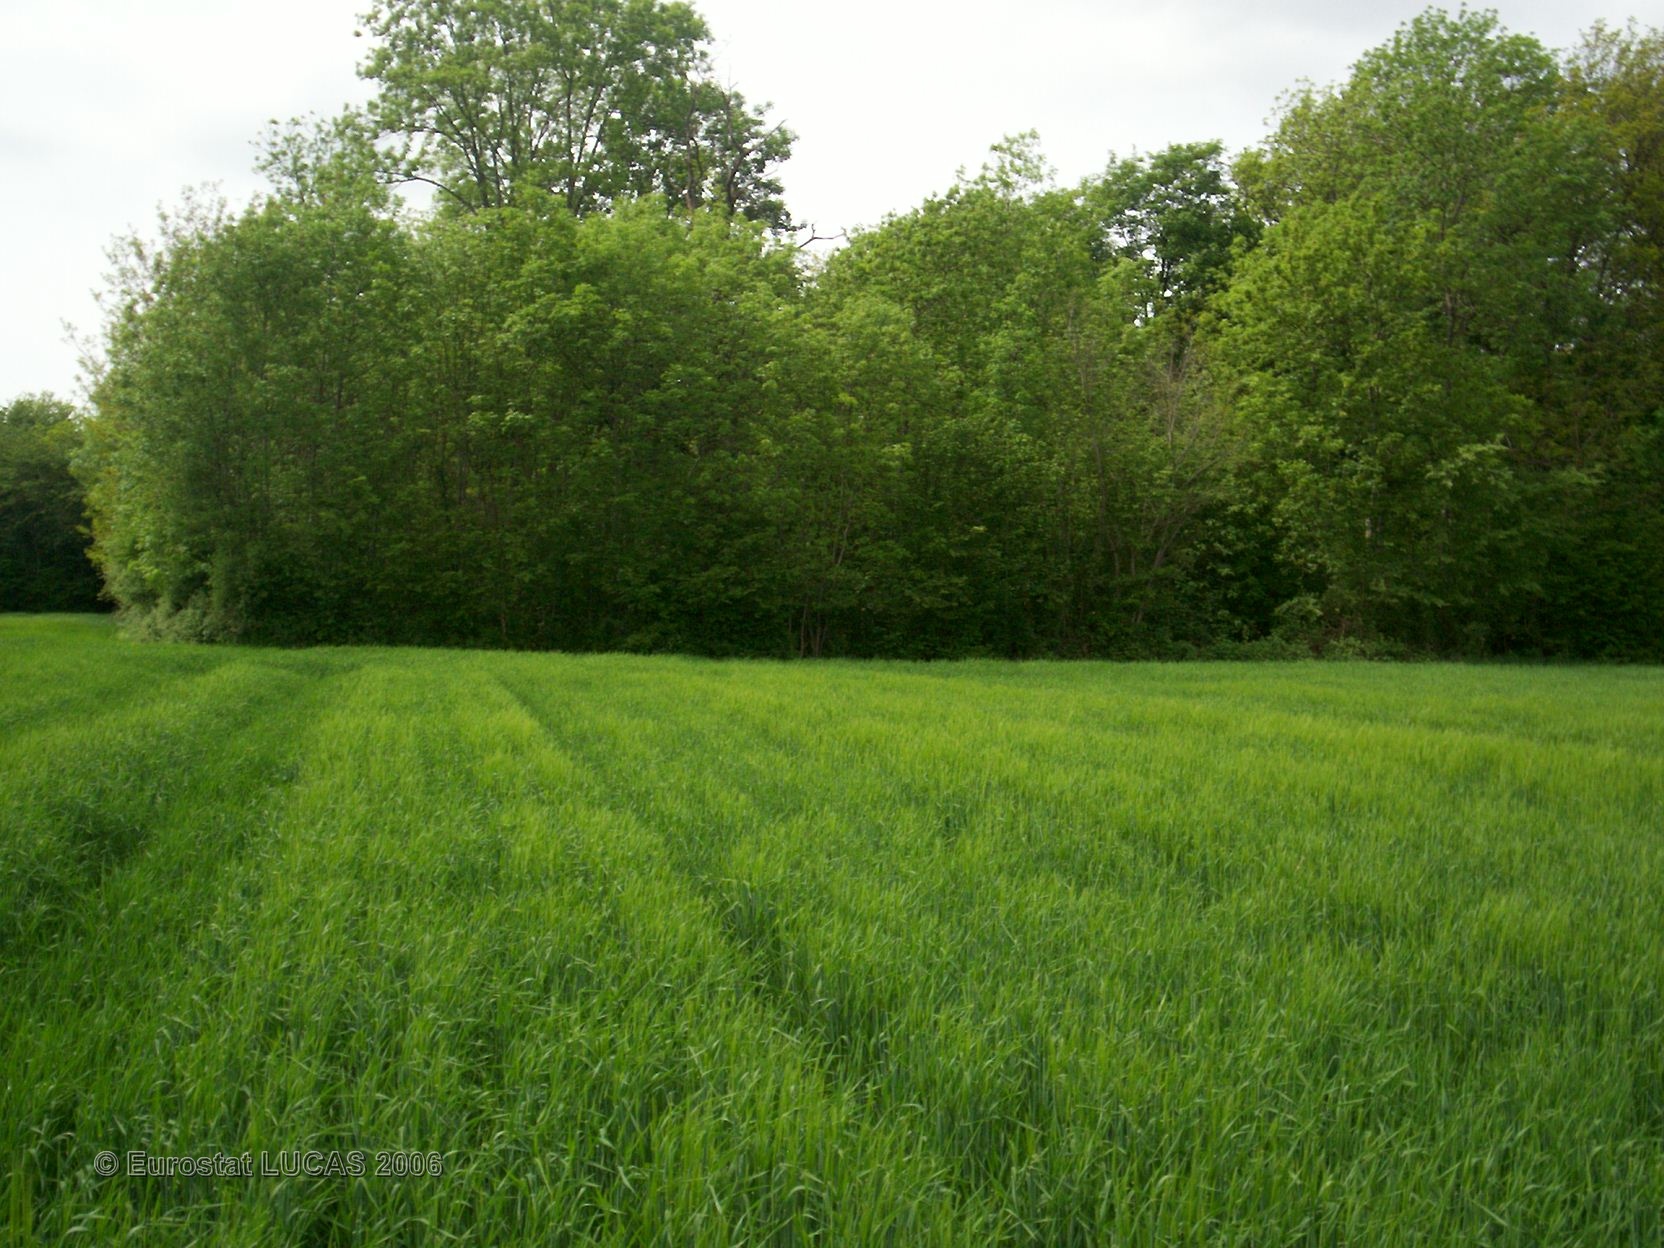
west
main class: Cropland
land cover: Barley
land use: Agriculture (excluding fallow land and kitchen gardens)
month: May
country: FR
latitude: 47.3317
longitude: 4.5608
